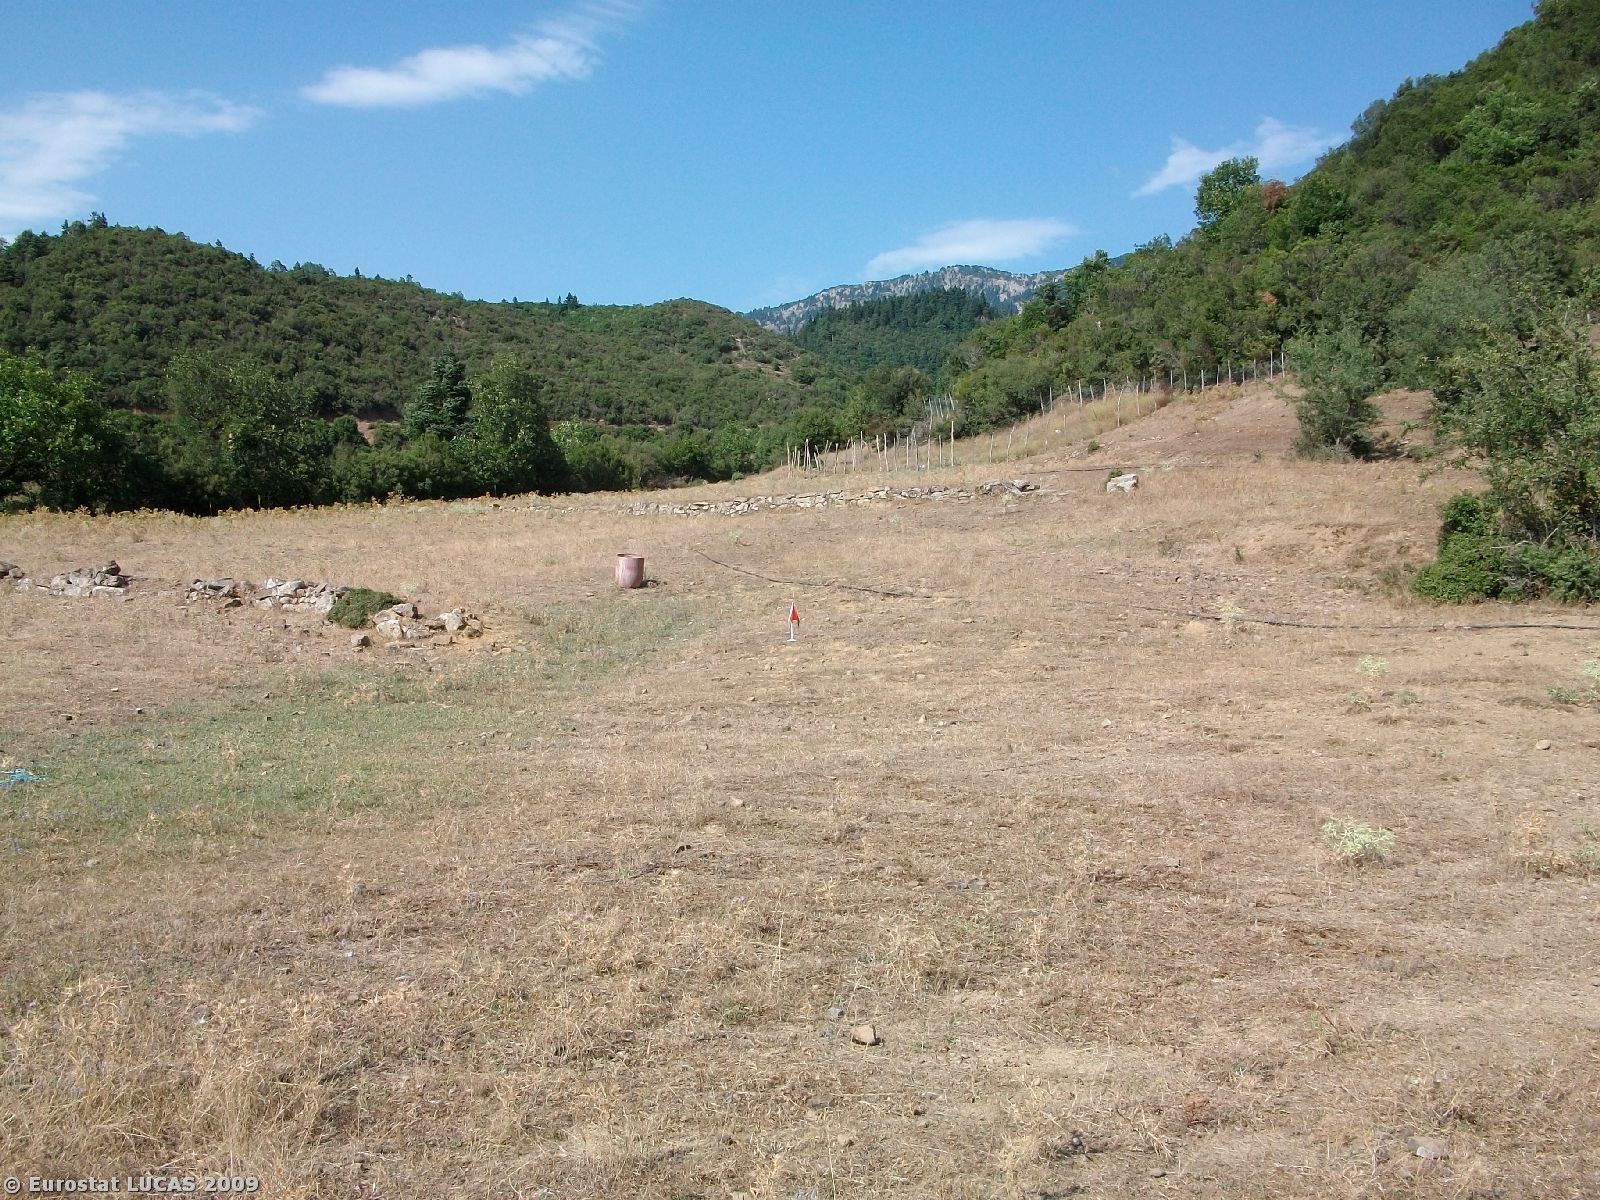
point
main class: Grassland
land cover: Grassland without tree/shrub cover
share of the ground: > 75 %
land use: Agriculture (excluding fallow land and kitchen gardens)
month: August
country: GR
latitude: 39.0566
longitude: 21.5201
